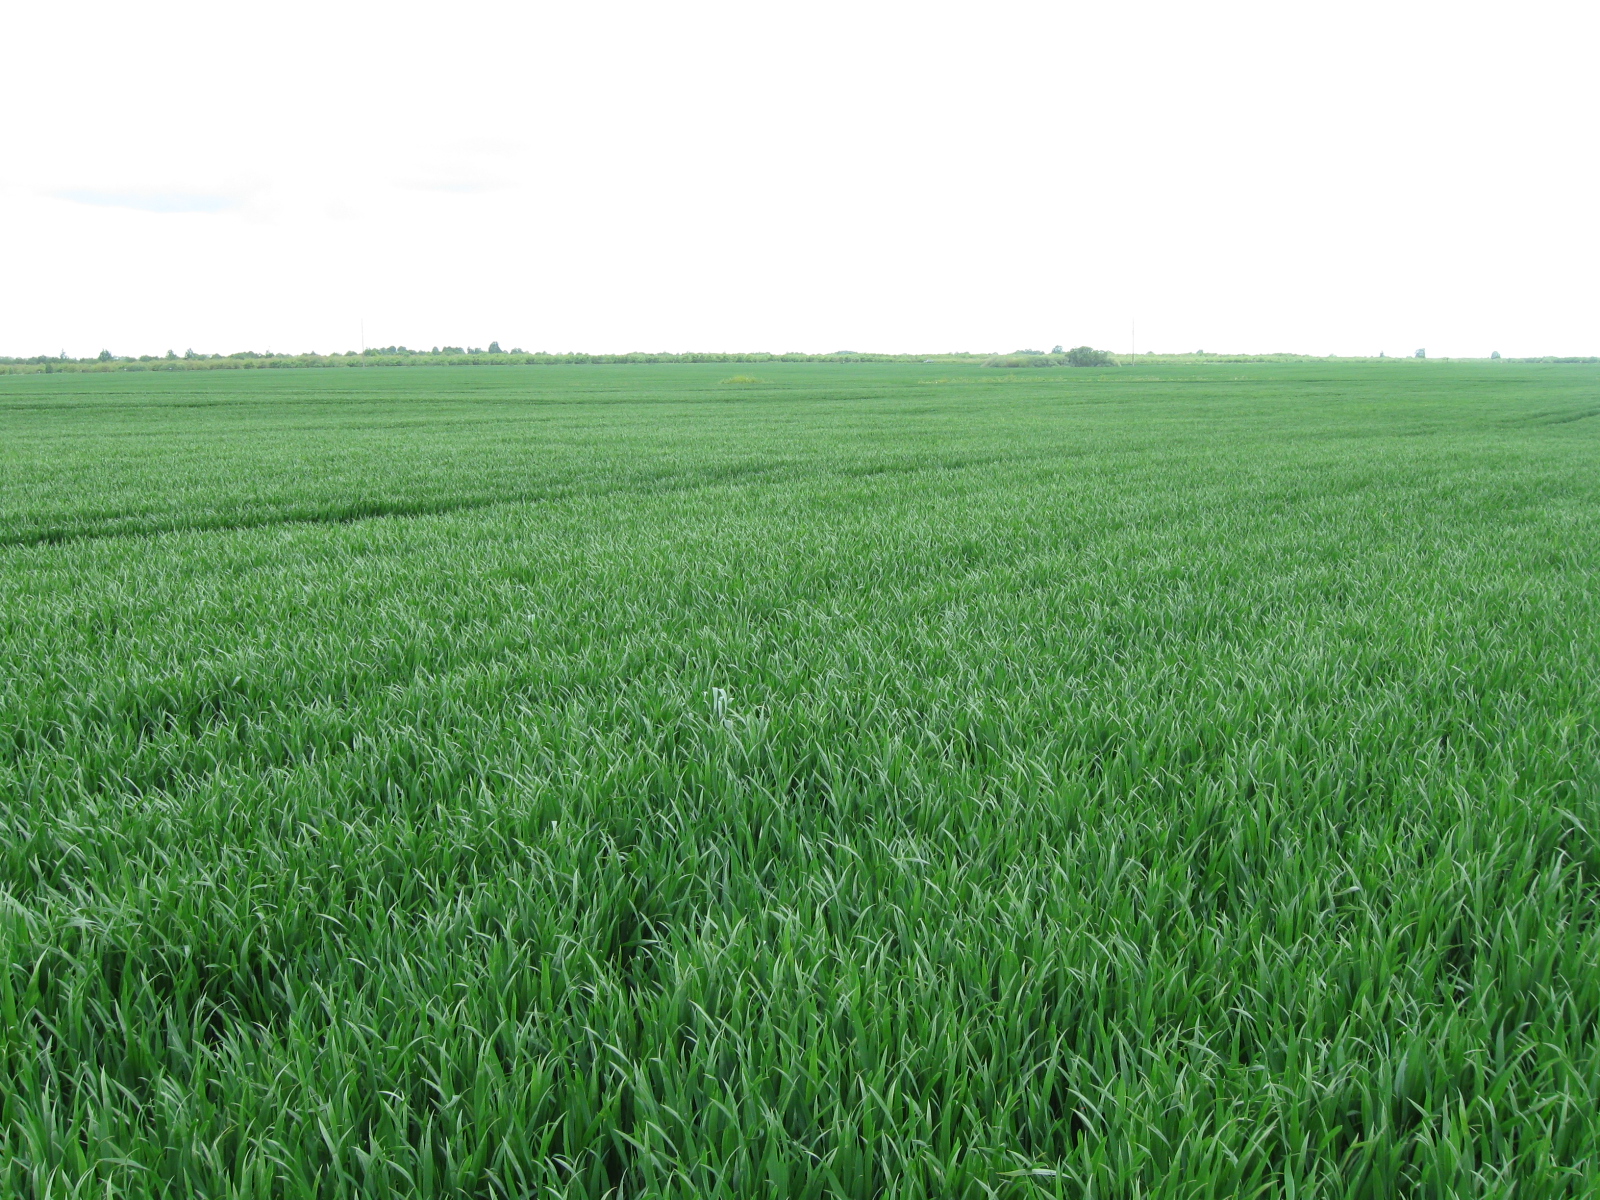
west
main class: Cropland
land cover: Common wheat
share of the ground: > 75 %
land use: Agriculture (excluding fallow land and kitchen gardens)
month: May
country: LT
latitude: 54.6831
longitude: 22.8345
